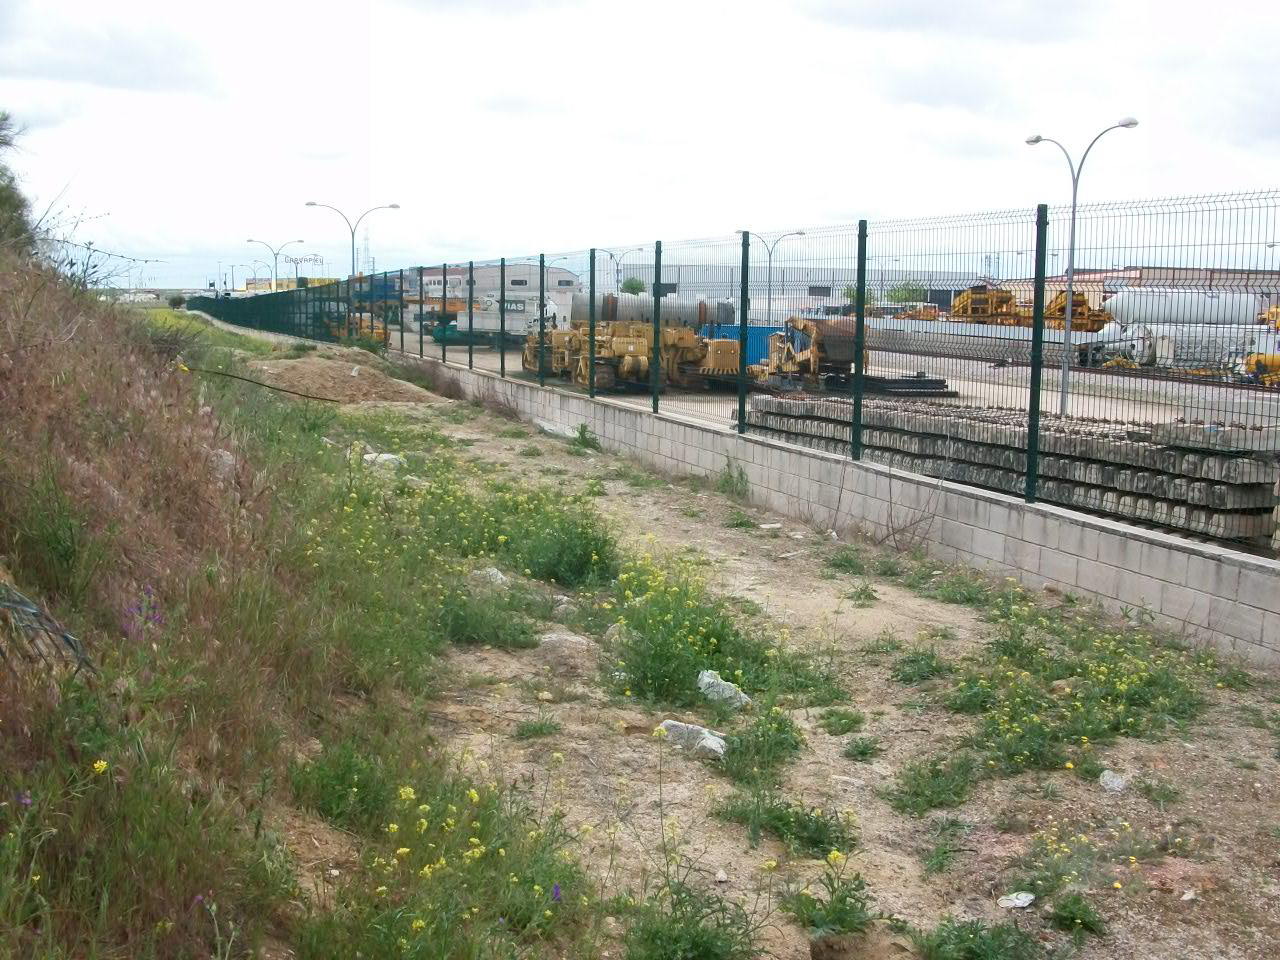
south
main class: Shrubland
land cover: Shrubland without tree cover
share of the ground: > 75 %
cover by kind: shrubs 95 %, herbaceous plants 5 %
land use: Abandoned areas
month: April
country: ES
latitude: 40.2751
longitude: -3.8088
